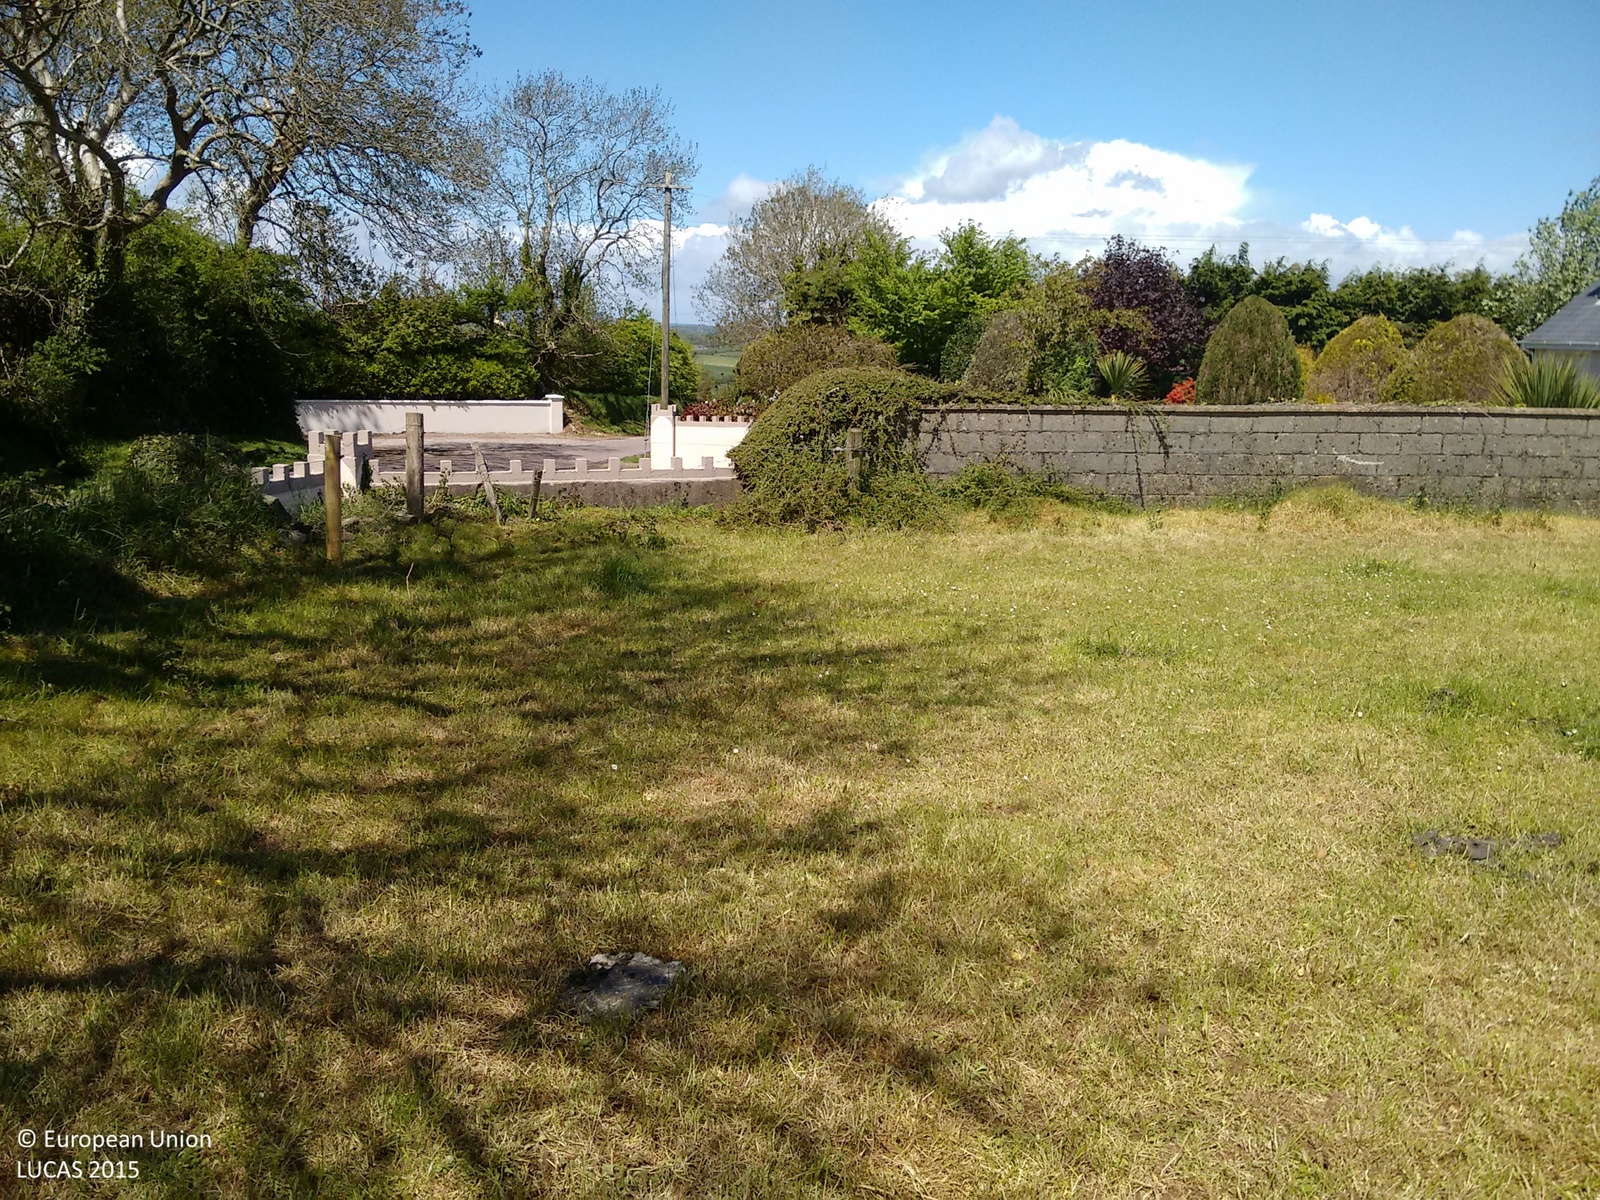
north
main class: Grassland
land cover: Grassland without tree/shrub cover
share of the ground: > 75 %
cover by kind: herbaceous plants 95 %, shrubs 5 %
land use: Agriculture (excluding fallow land and kitchen gardens)
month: May
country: IE
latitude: 51.9301
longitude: -8.3228
